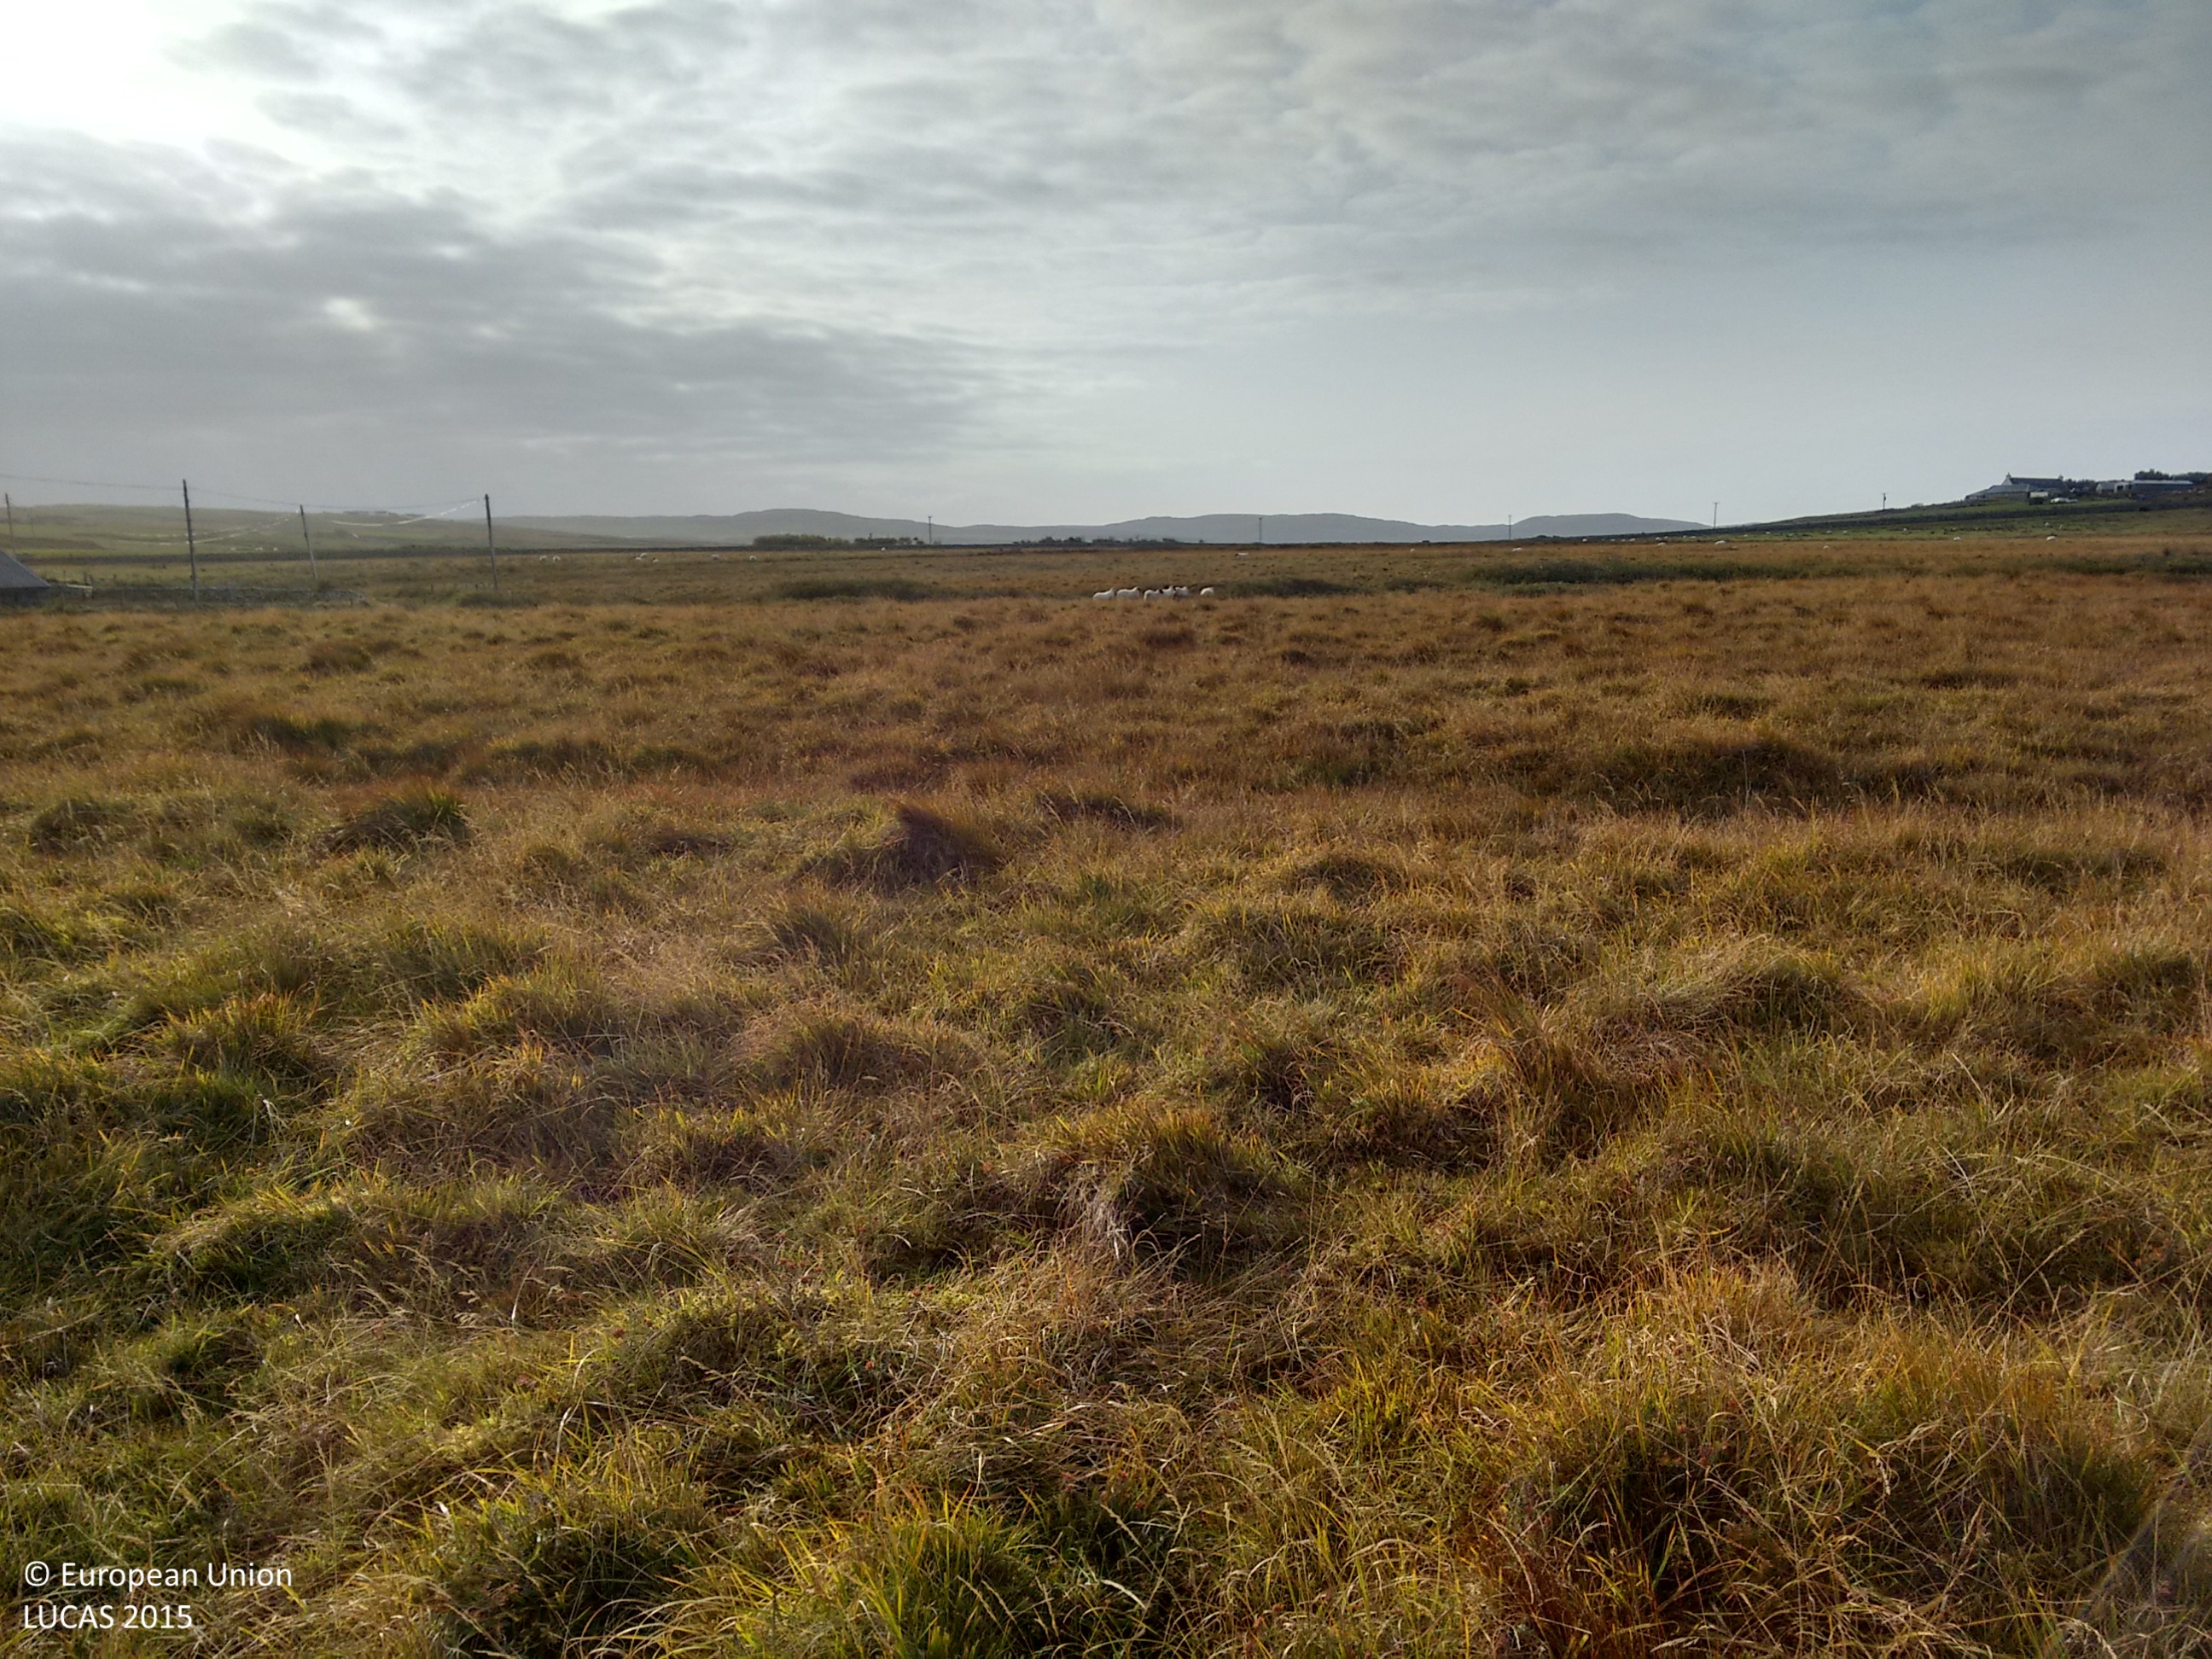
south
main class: Grassland
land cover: Grassland without tree/shrub cover
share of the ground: > 75 %
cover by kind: herbaceous plants 85 %, lichens and mosses 10 %, shrubs 5 %
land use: Agriculture (excluding fallow land and kitchen gardens)
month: October
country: GB
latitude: 55.8365
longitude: -6.4192
